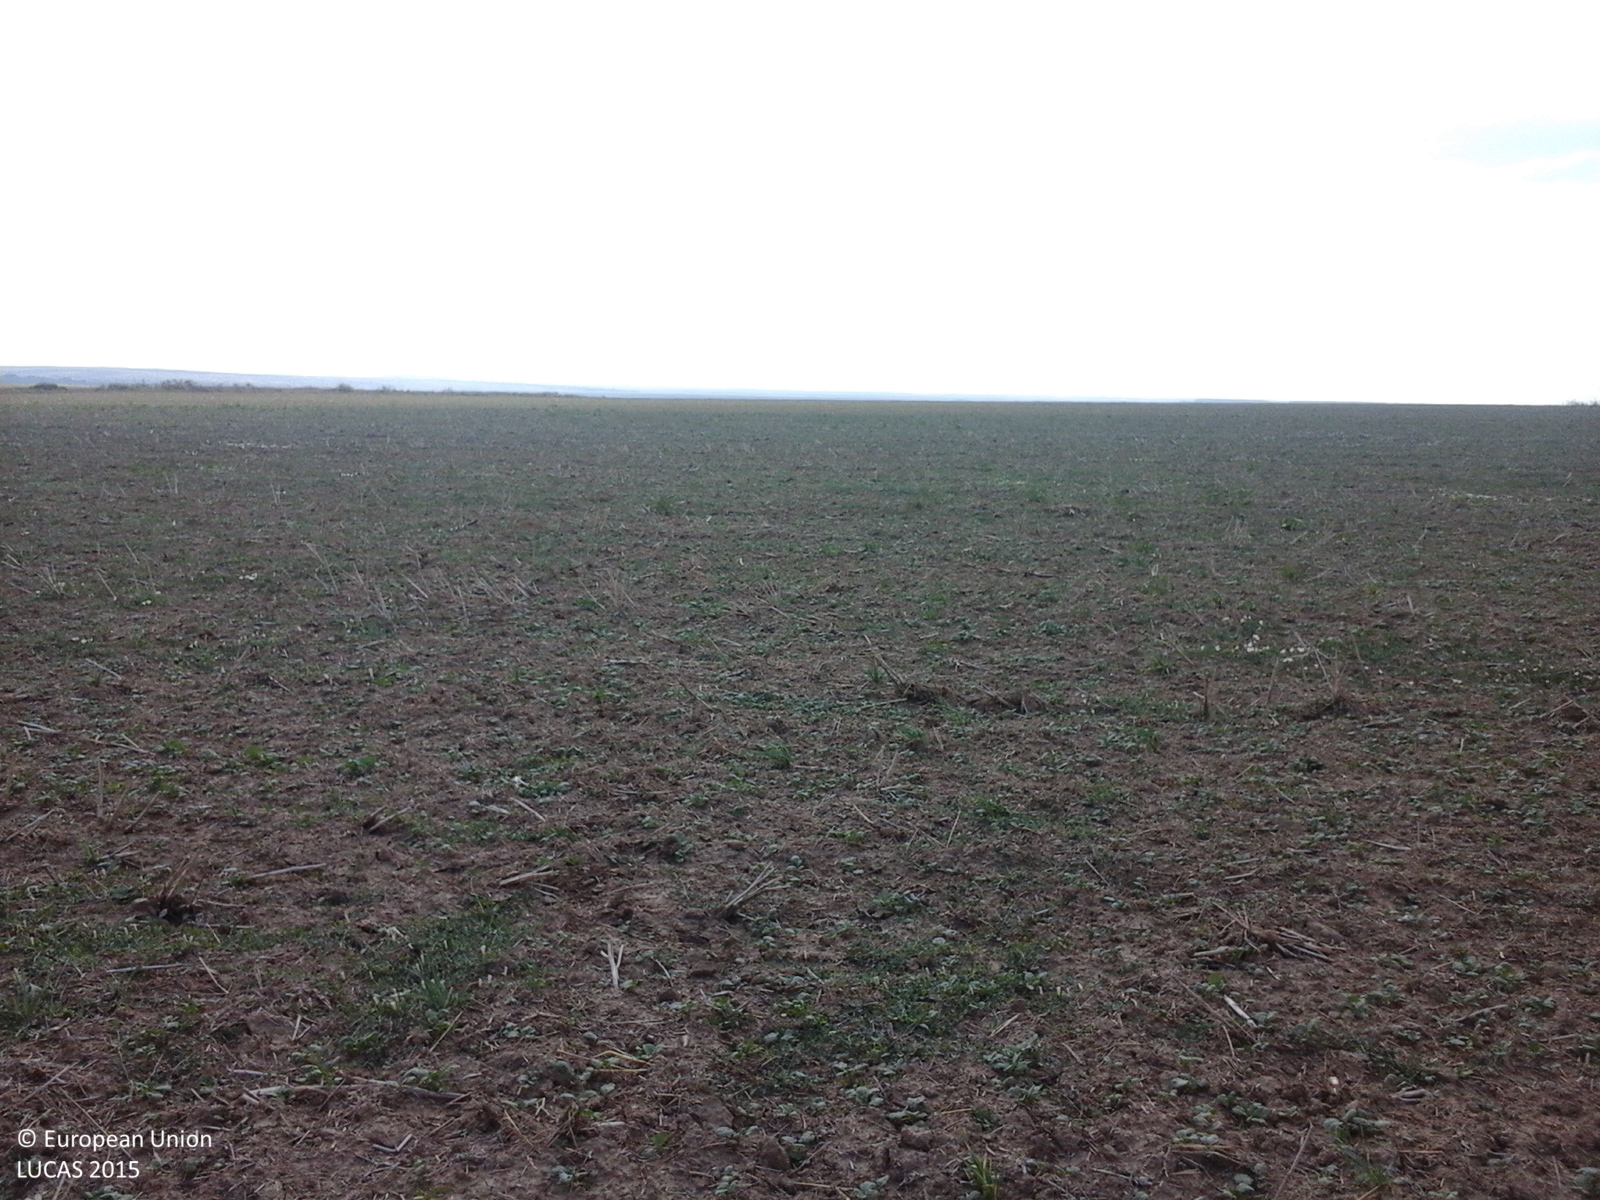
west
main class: Cropland
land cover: Rape and turnip rape
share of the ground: 10 - 25 %
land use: Agriculture (excluding fallow land and kitchen gardens)
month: August
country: RO
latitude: 44.7510
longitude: 28.1133
